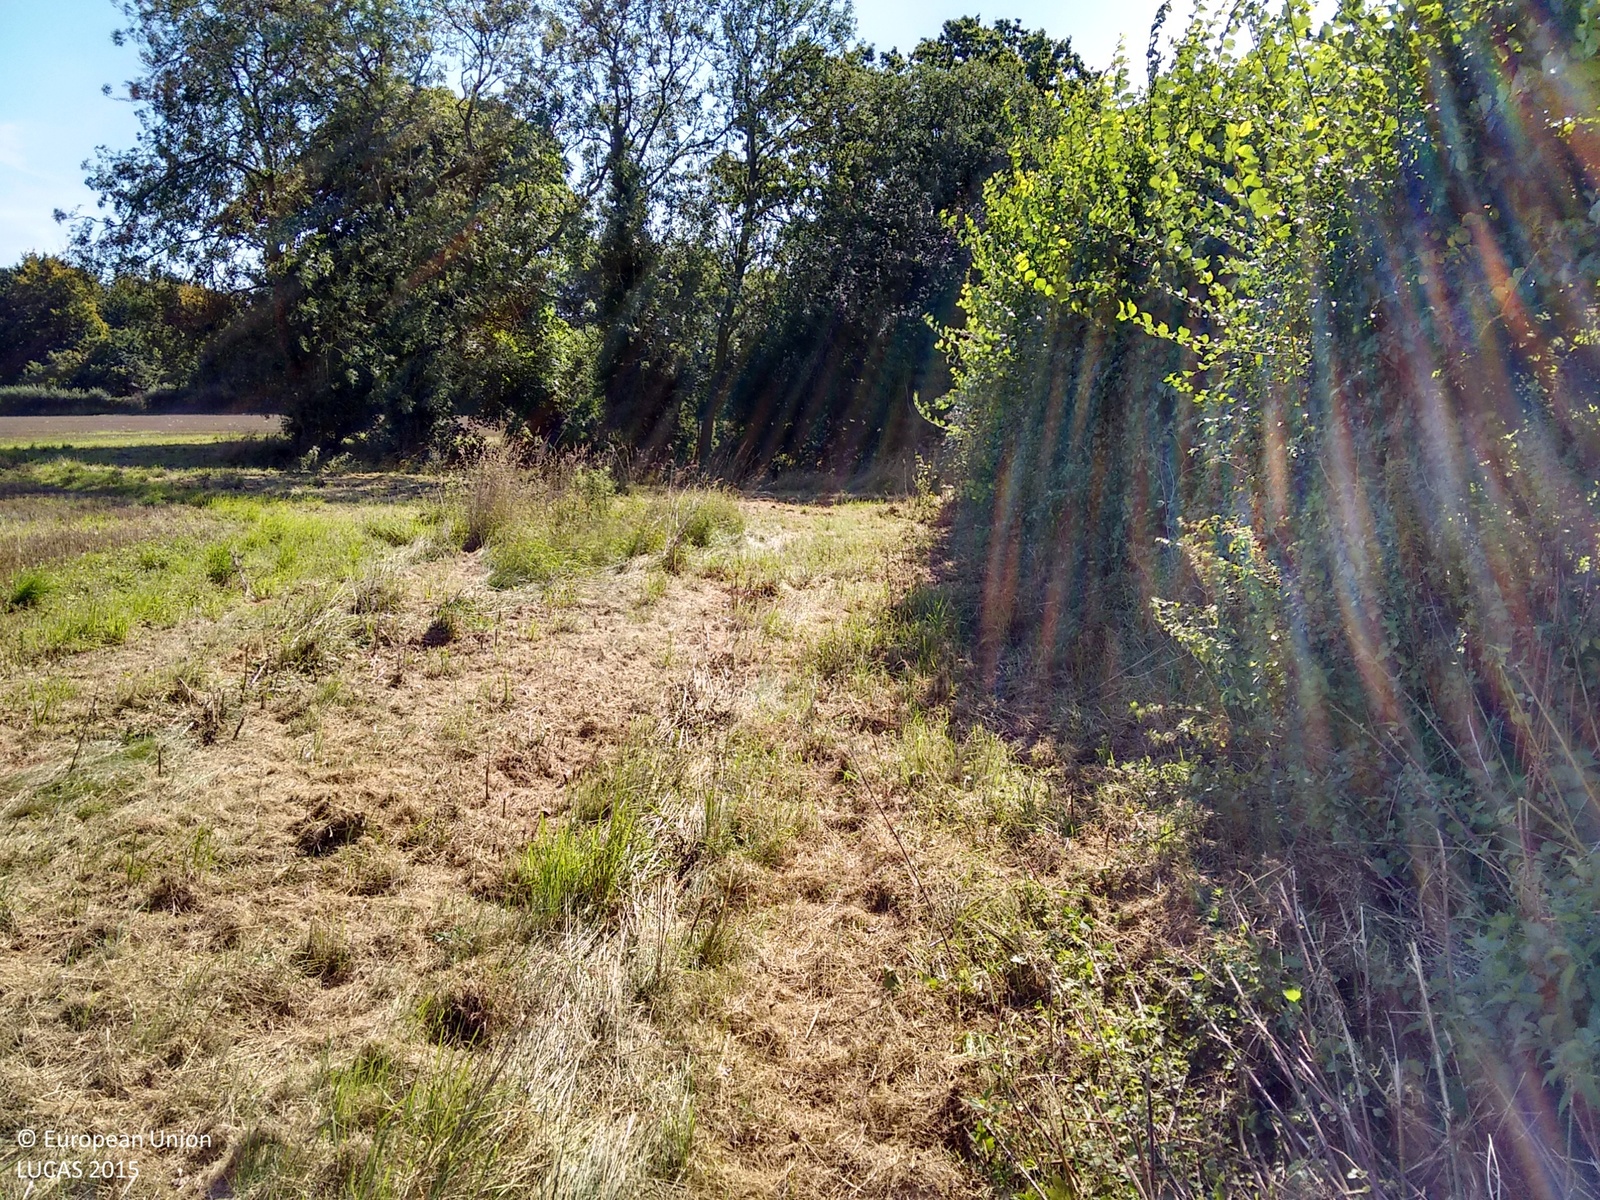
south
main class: Grassland
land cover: Grassland with sparse tree/shrub cover
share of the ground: > 75 %
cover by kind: herbaceous plants 95 %, broadleaved forest trees 5 %
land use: Amenities, museums, leisure
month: September
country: GB
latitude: 52.4946
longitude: 0.8585
